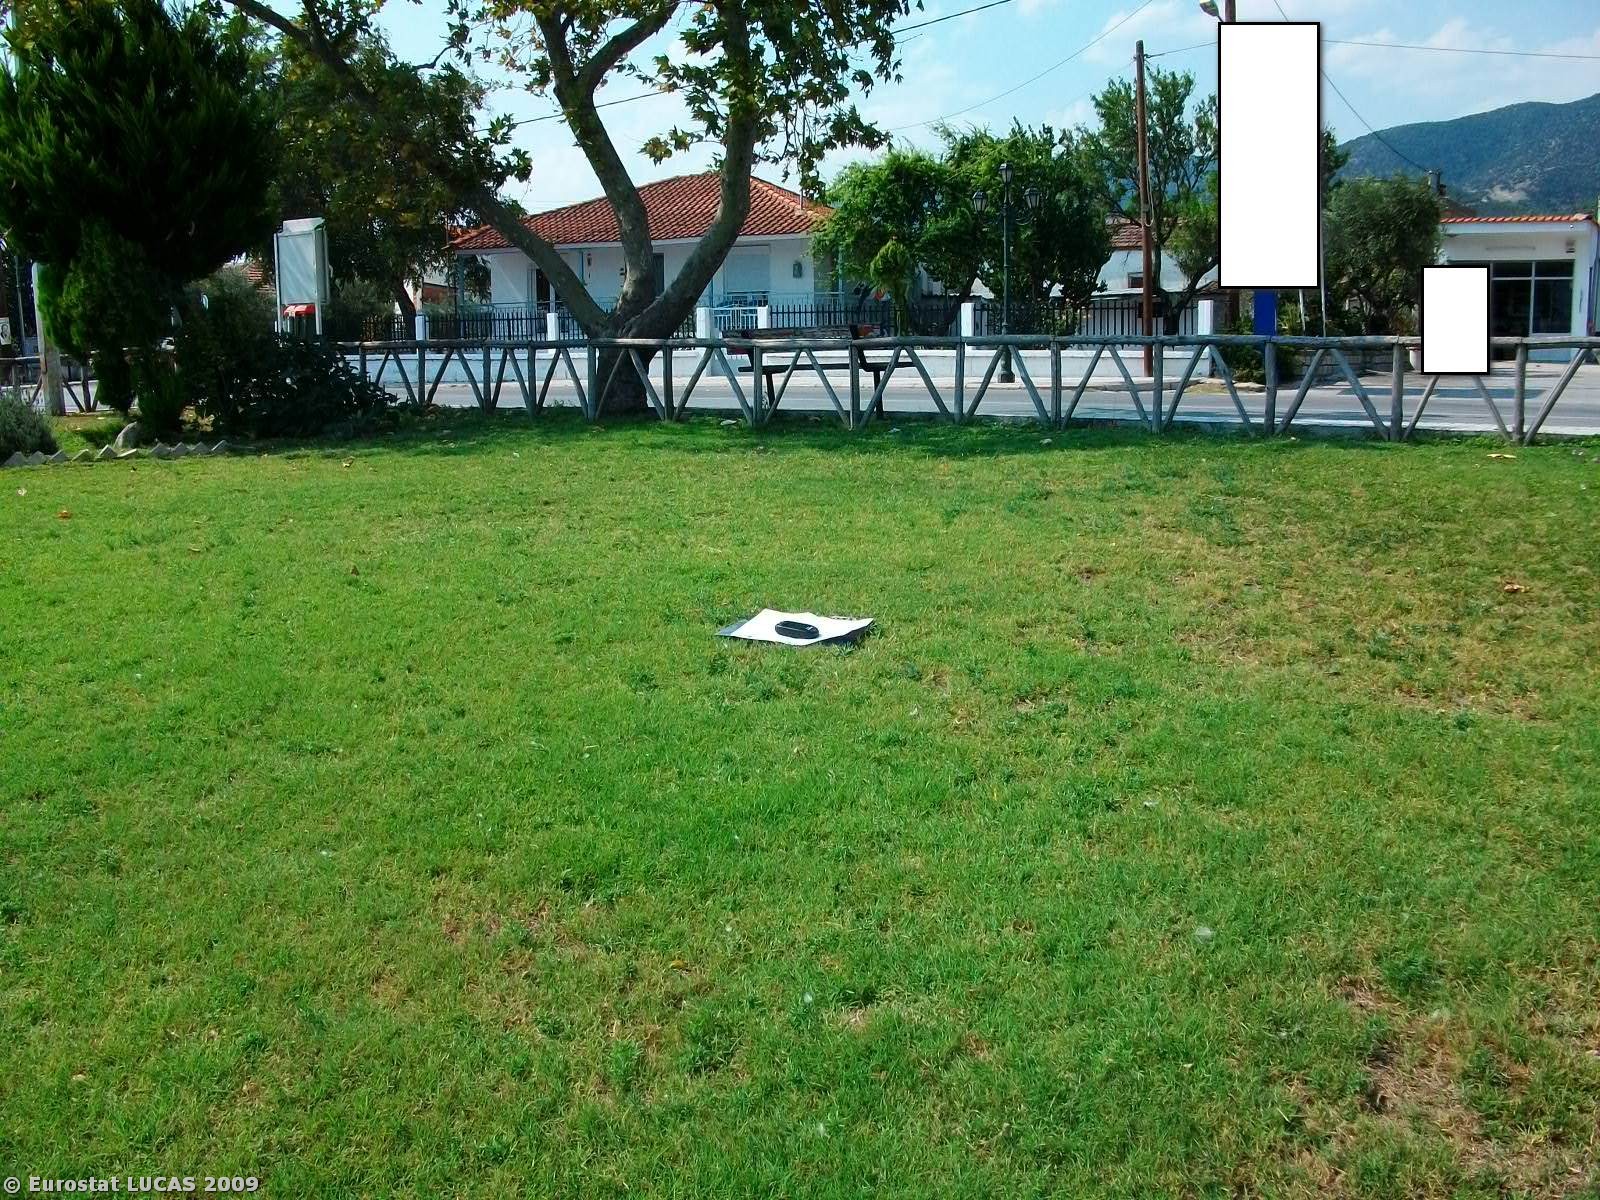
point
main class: Grassland
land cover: Grassland with sparse tree/shrub cover
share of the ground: > 75 %
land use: Amenities, museums, leisure
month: August
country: GR
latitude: 40.6760
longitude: 23.5615
